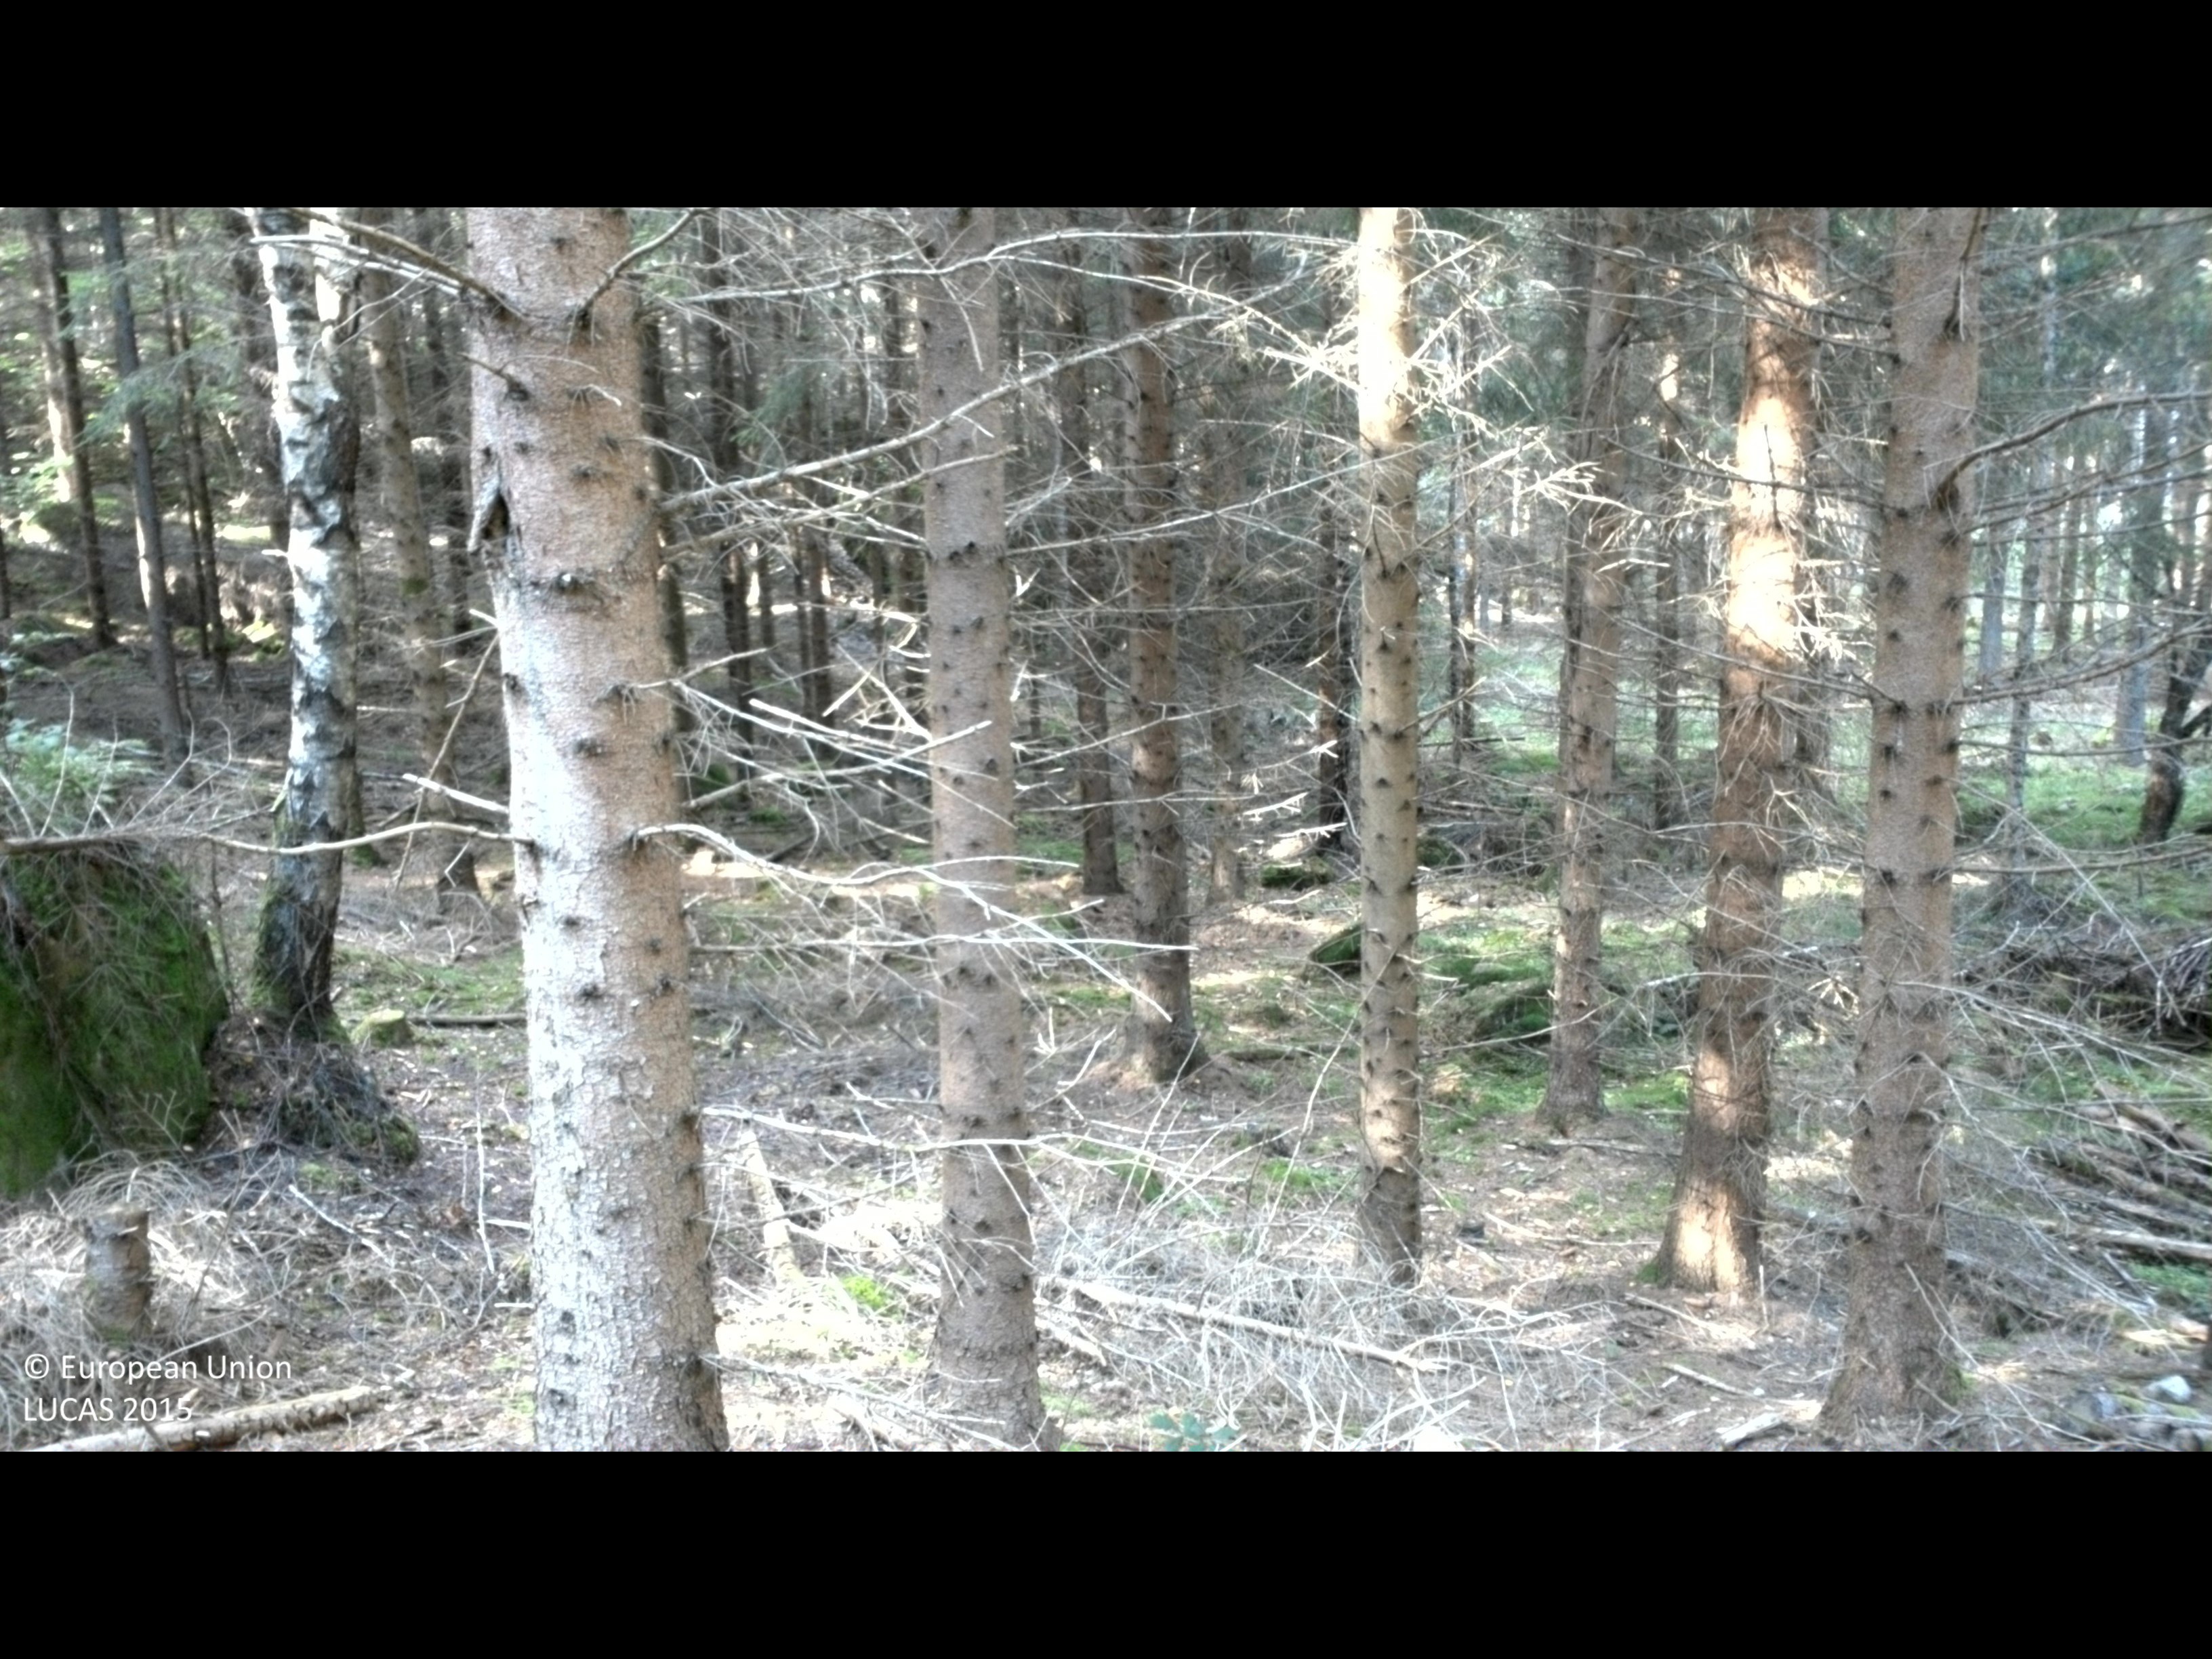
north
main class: Woodland
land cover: Spruce dominated coniferous woodland
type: boreal forest
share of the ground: 50 - 75 %
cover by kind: coniferous forest trees 55 %, lichens and mosses 30 %, shrubs 10 %, herbaceous plants 5 %
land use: Forestry
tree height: > 5 m
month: August
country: SE
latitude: 56.3090
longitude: 14.4429
